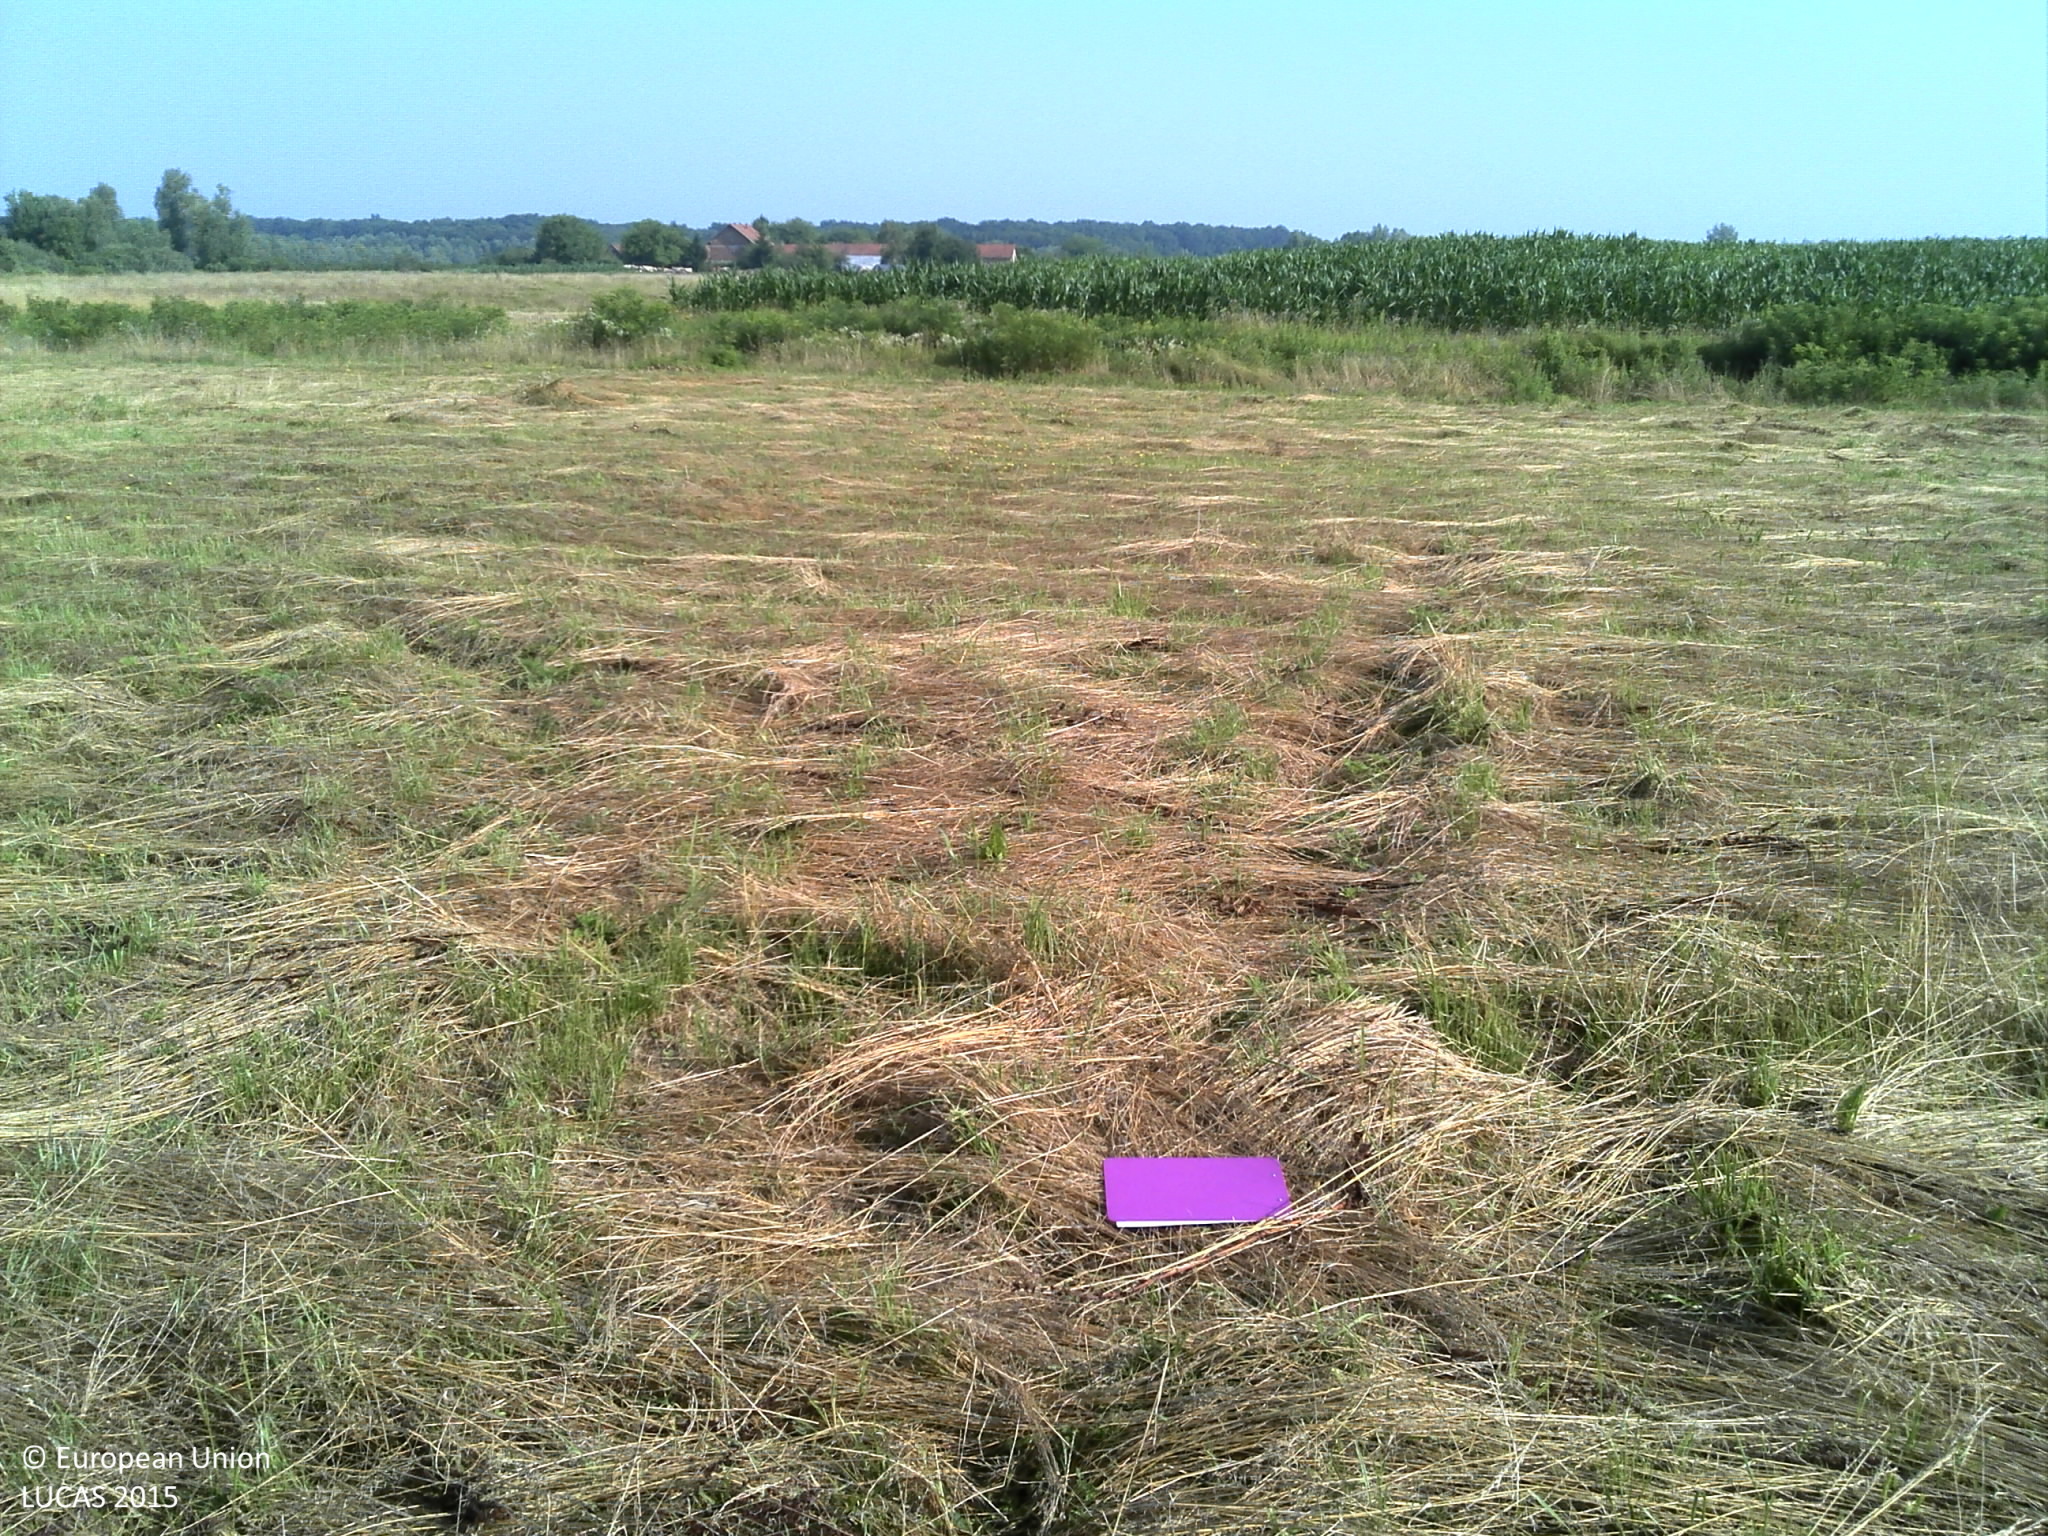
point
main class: Cropland
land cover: Temporary grasslands
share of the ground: > 75 %
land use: Agriculture (excluding fallow land and kitchen gardens)
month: July
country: HR
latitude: 45.7517
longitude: 16.5681
